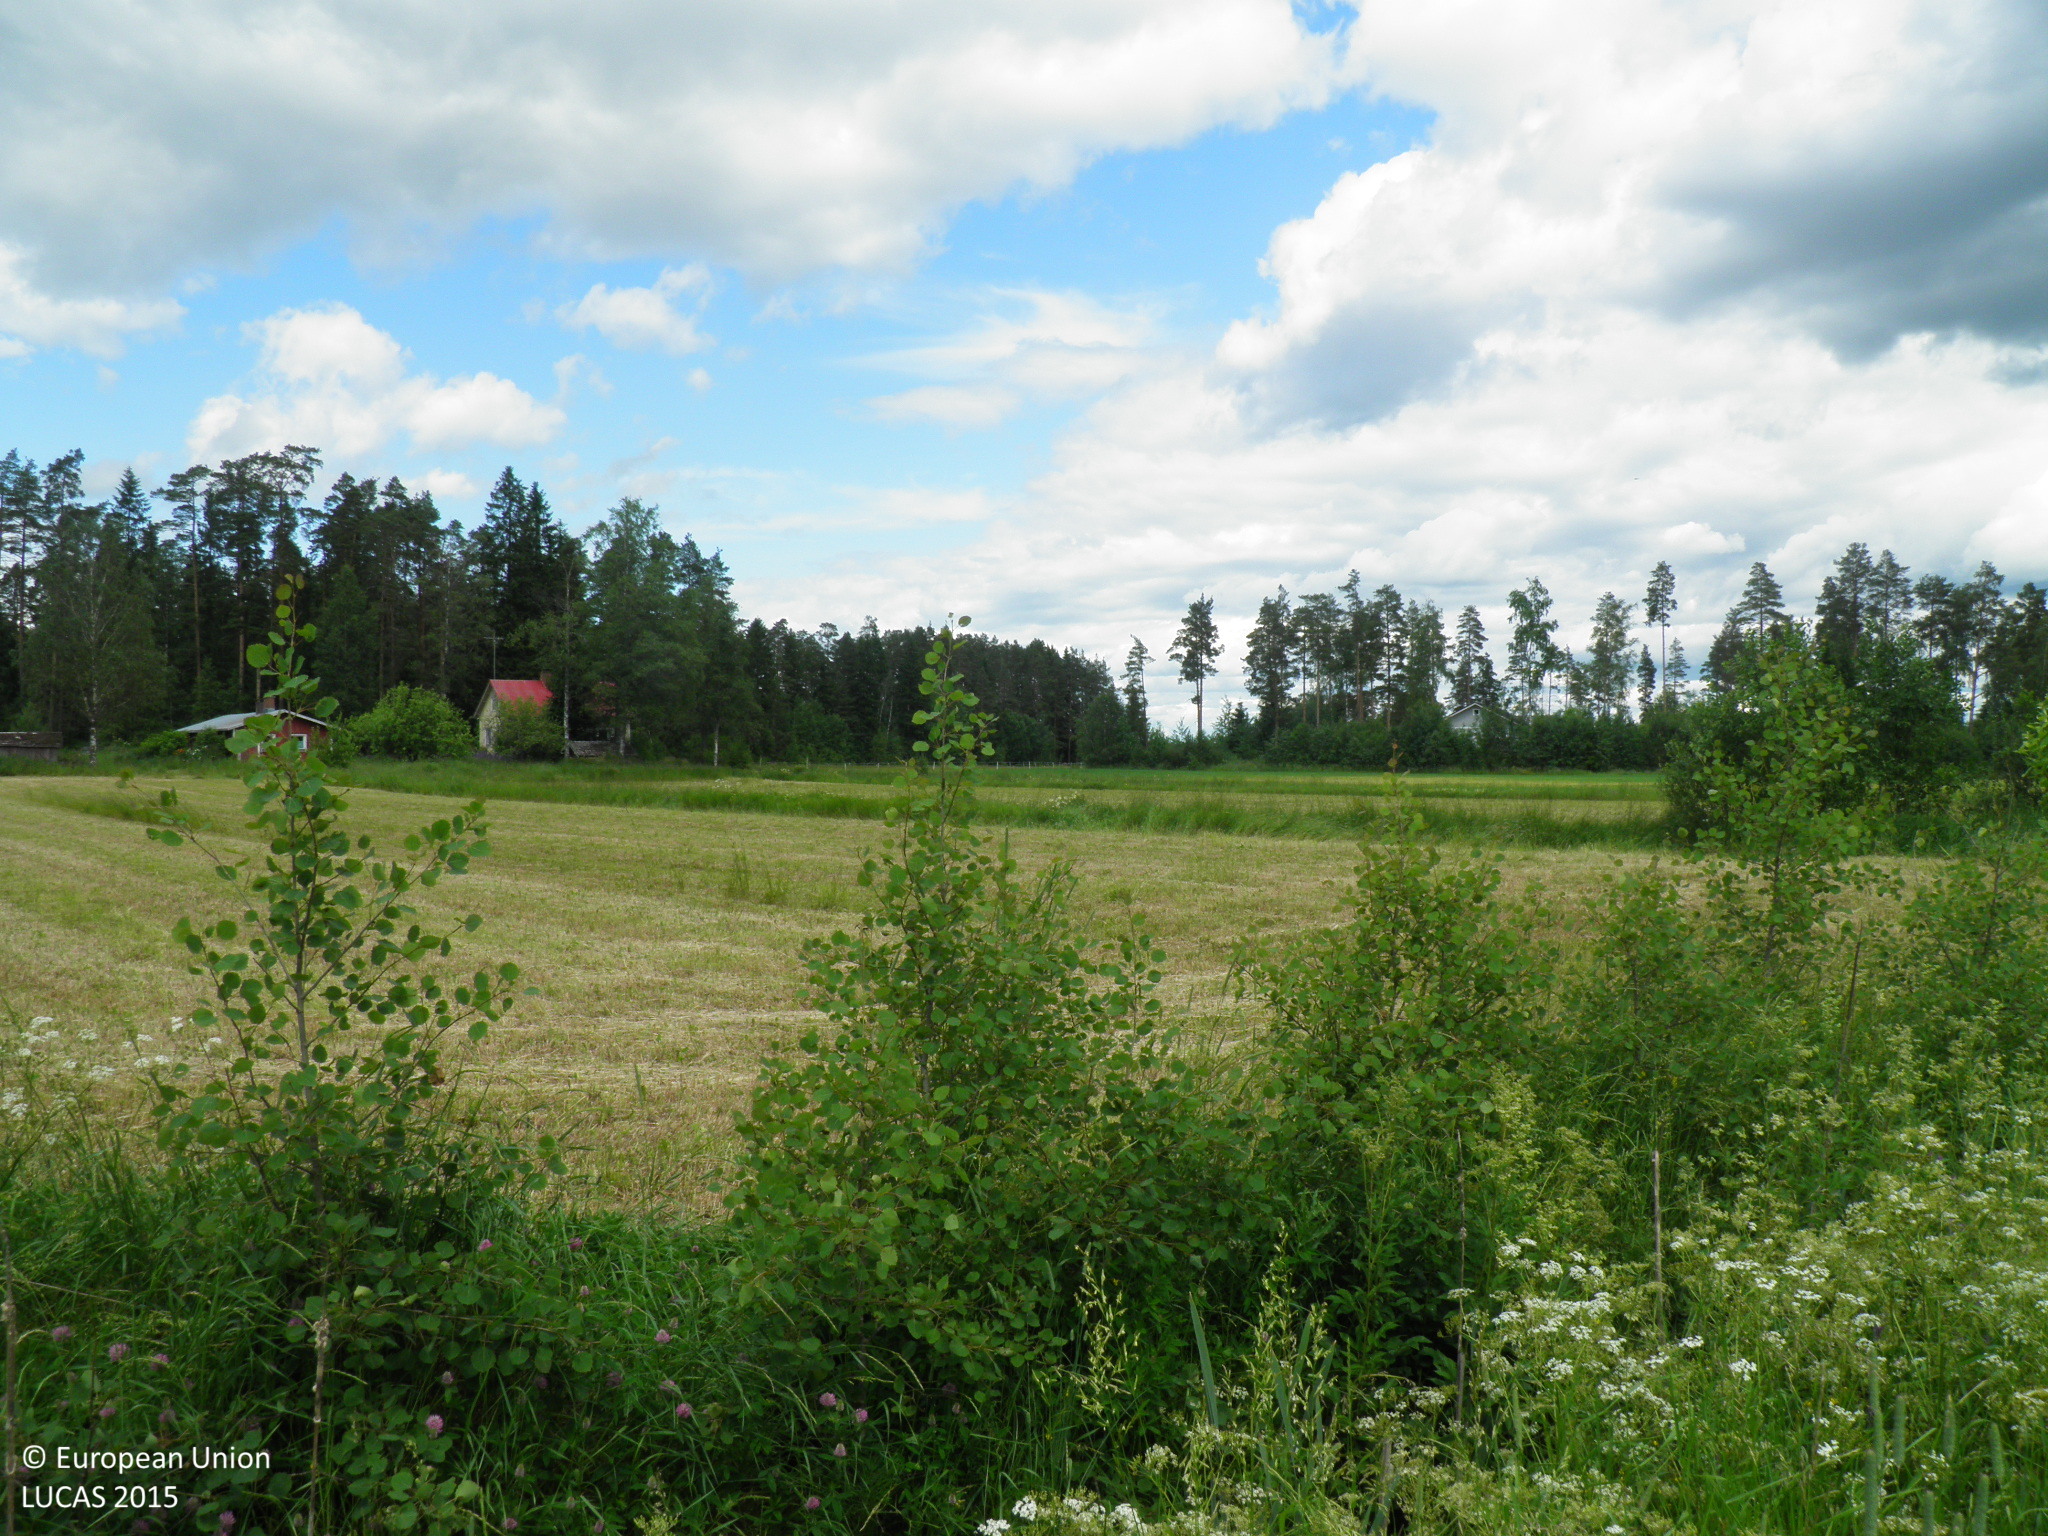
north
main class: Cropland
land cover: Common wheat
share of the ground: > 75 %
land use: Agriculture (excluding fallow land and kitchen gardens)
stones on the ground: < 10 %
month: July
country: FI
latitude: 60.6040
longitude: 22.9528
